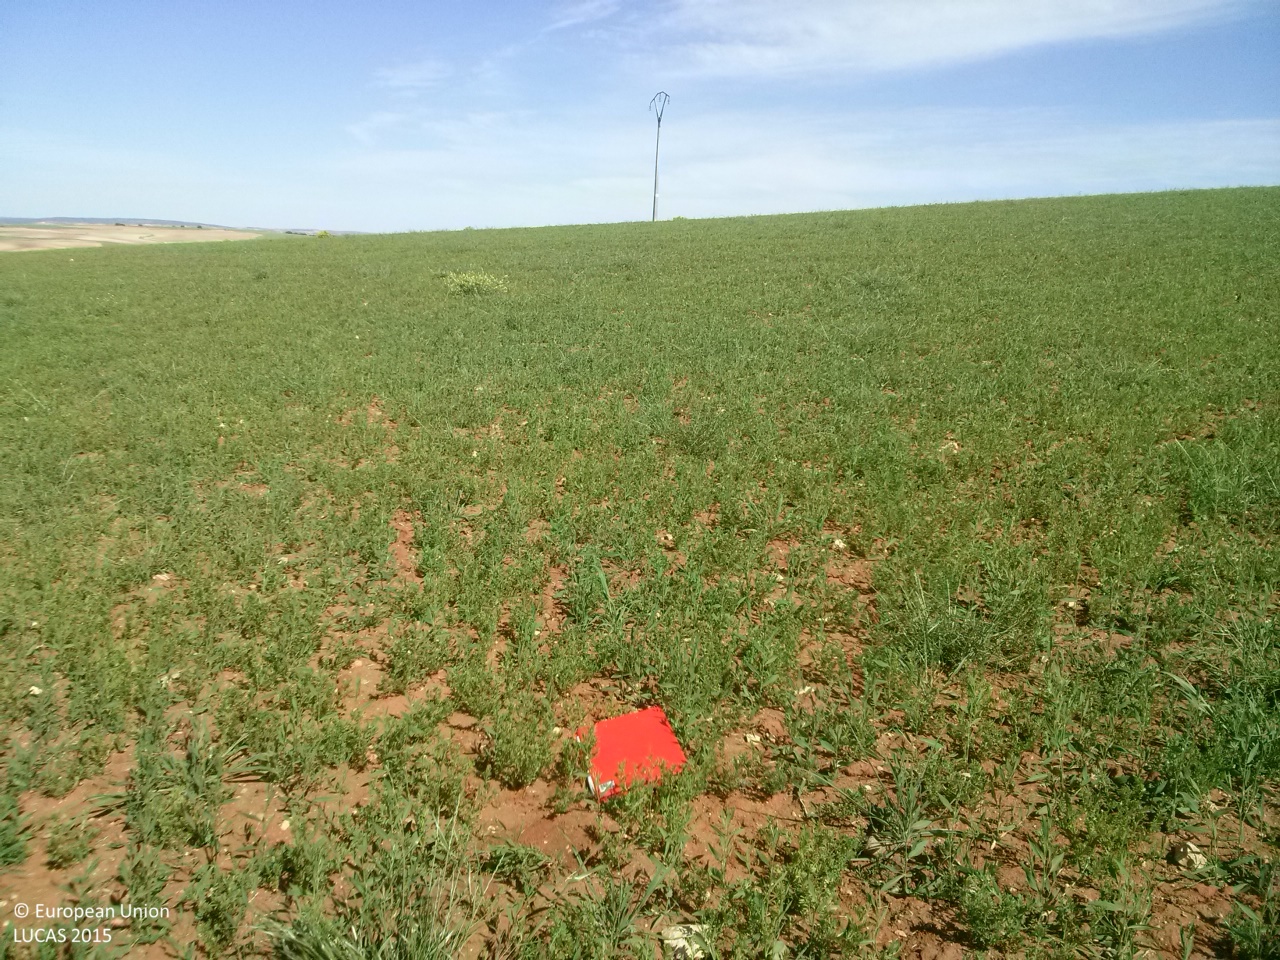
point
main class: Cropland
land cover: Dry pulses
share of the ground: 50 - 75 %
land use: Agriculture (excluding fallow land and kitchen gardens)
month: May
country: ES
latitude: 39.8202
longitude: -2.7174
